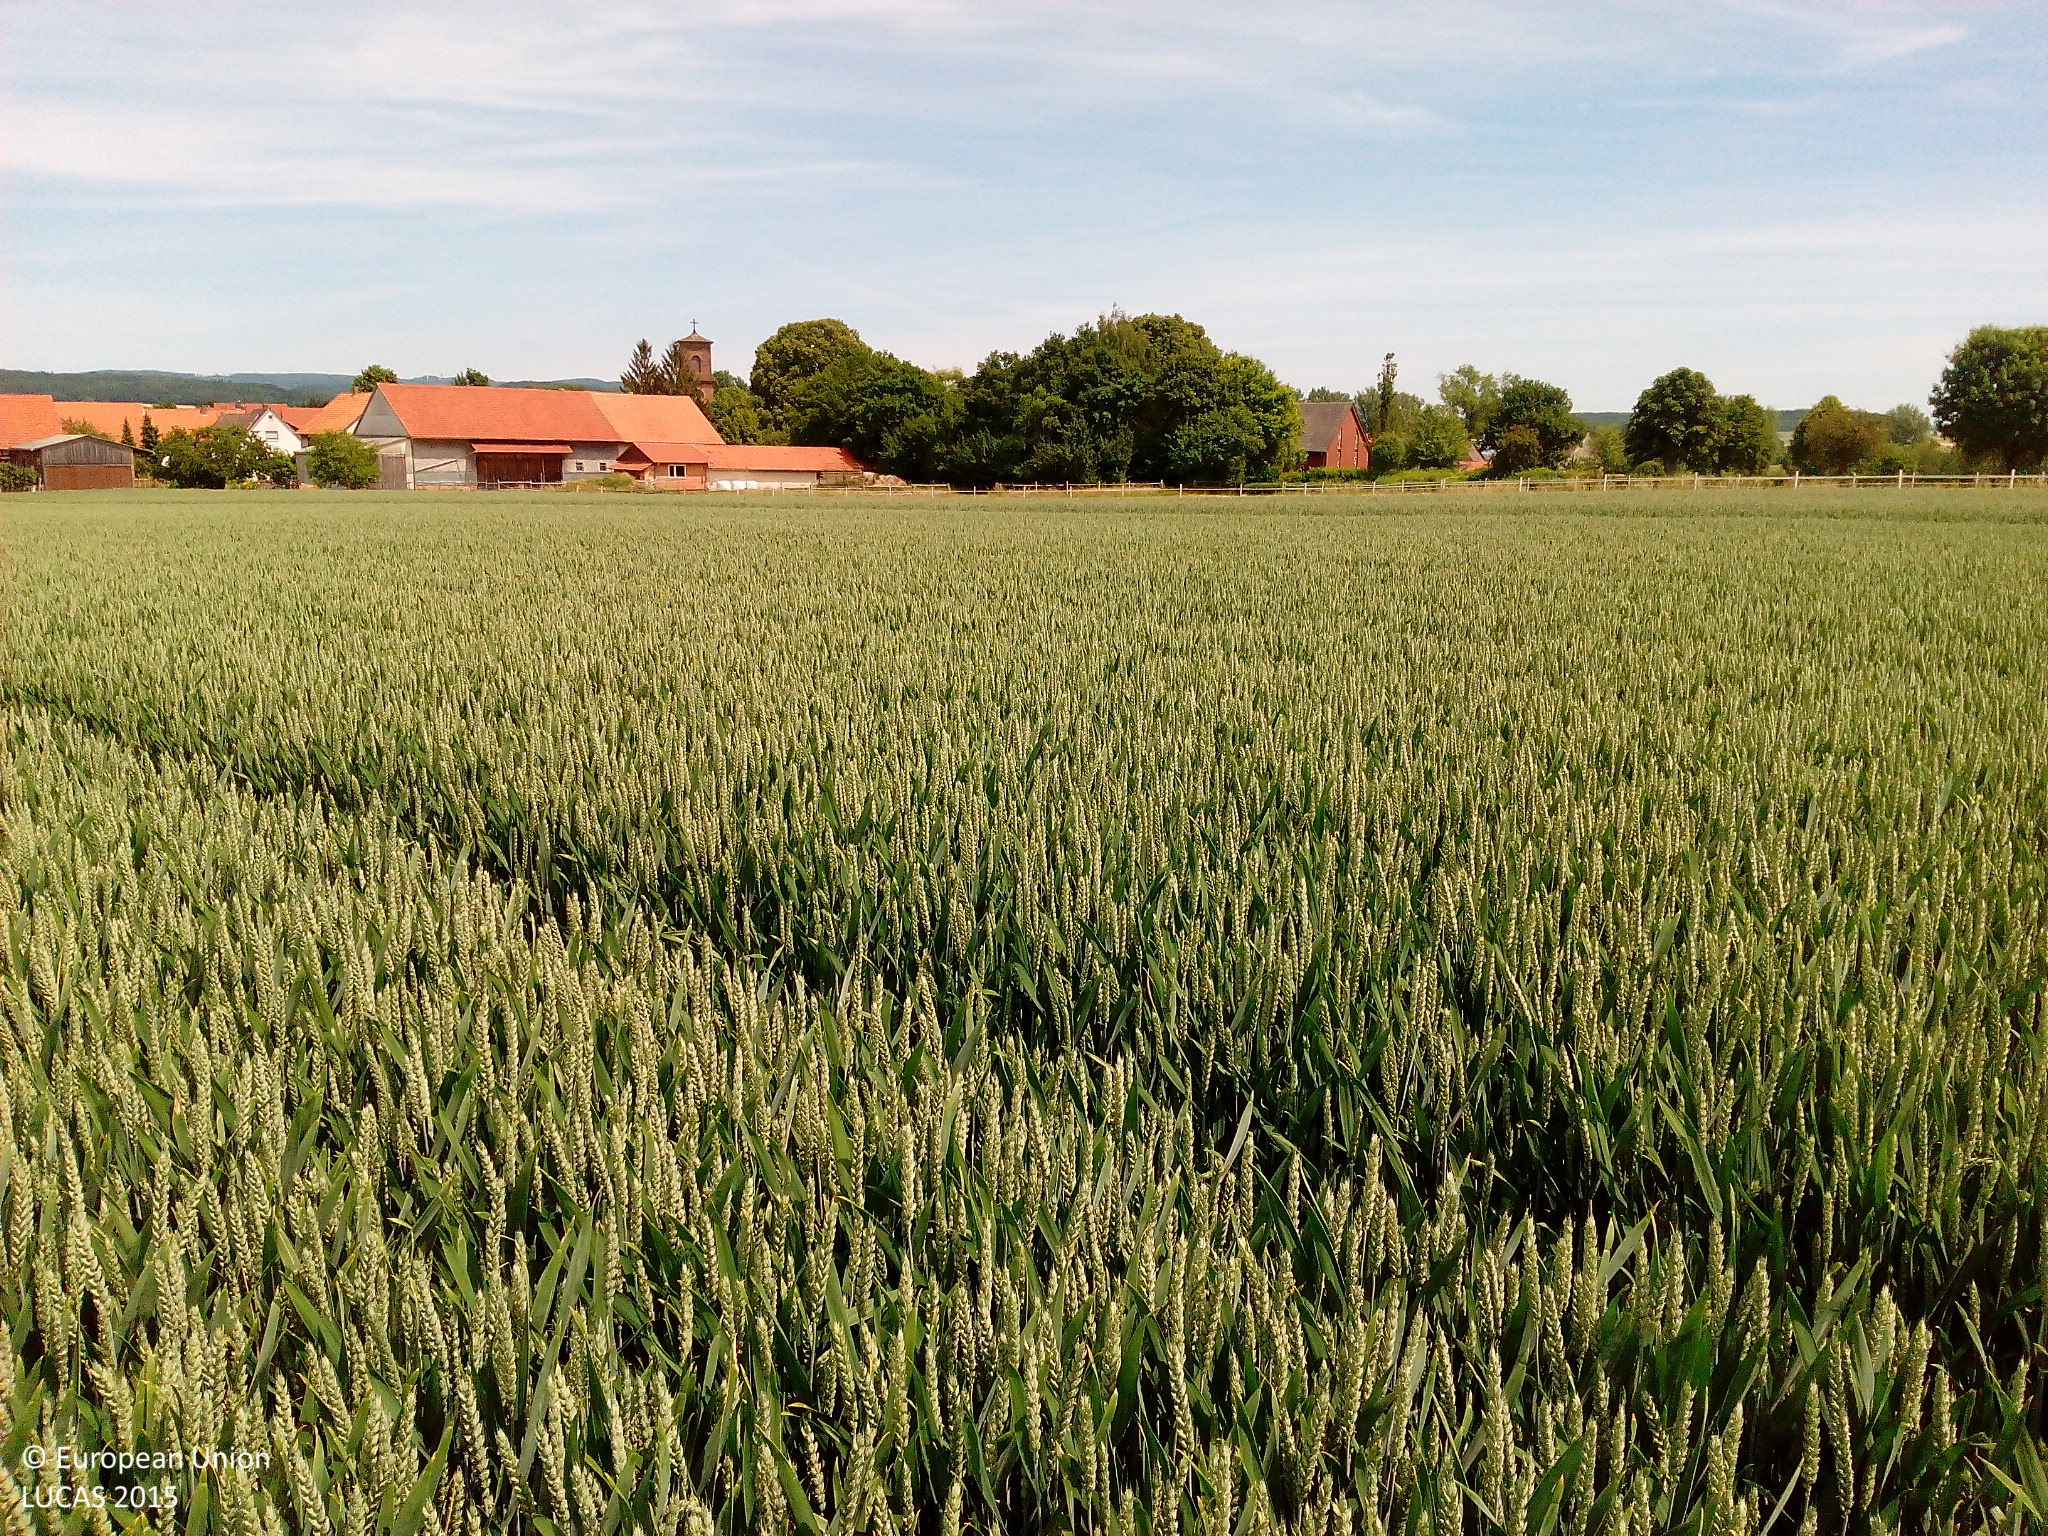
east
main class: Cropland
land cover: Common wheat
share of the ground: > 75 %
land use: Agriculture (excluding fallow land and kitchen gardens)
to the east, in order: Common wheat; Grass margins; Fences; Grassland without tree/shrub cover; Fences; Grassland without tree/shrub cover; Broadleaved woodland; Fences; Artificial constructions in urban areas
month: June
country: DE
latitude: 50.8830
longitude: 9.2469
